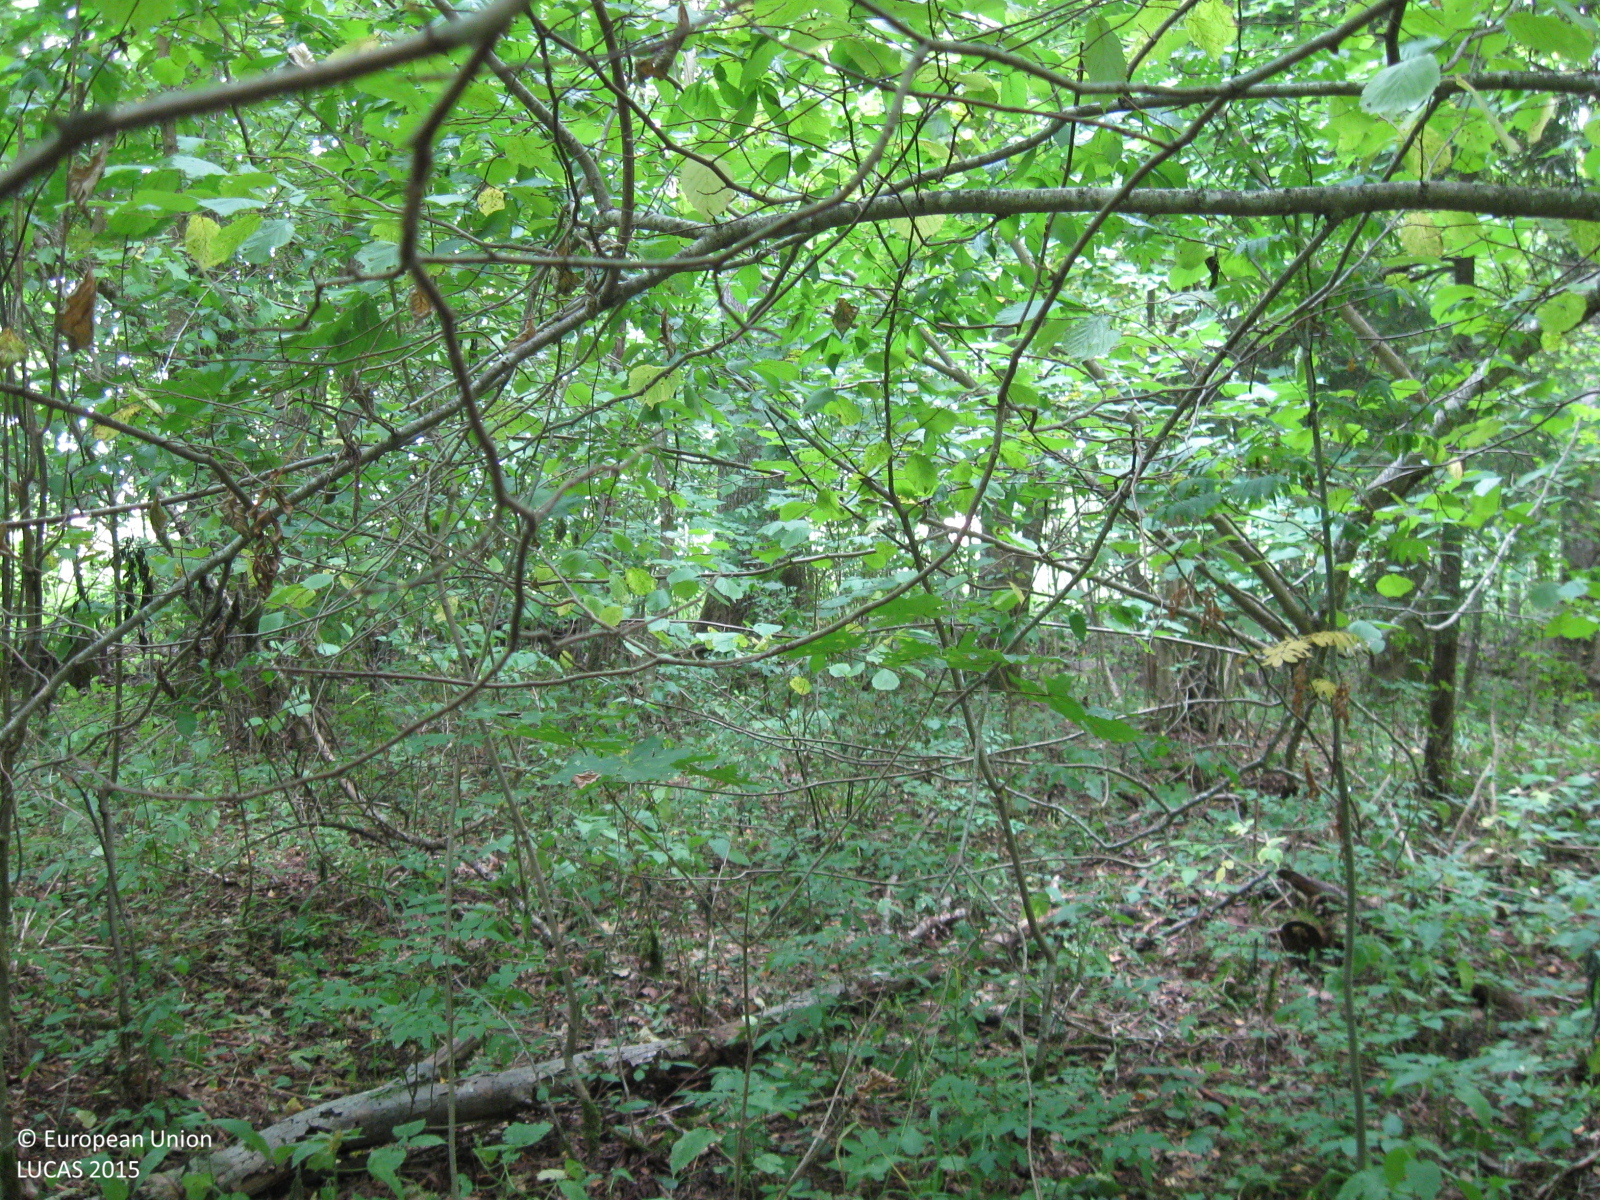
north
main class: Woodland
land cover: Other mixed woodland
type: hemiboreal forest and nemoral coniferous forest and mixed broadleaved-coniferous forest
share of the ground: > 75 %
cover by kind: broadleaved forest trees 55 %, coniferous forest trees 45 %
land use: Forestry
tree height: > 5 m
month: August
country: LT
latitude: 55.1520
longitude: 23.4011
